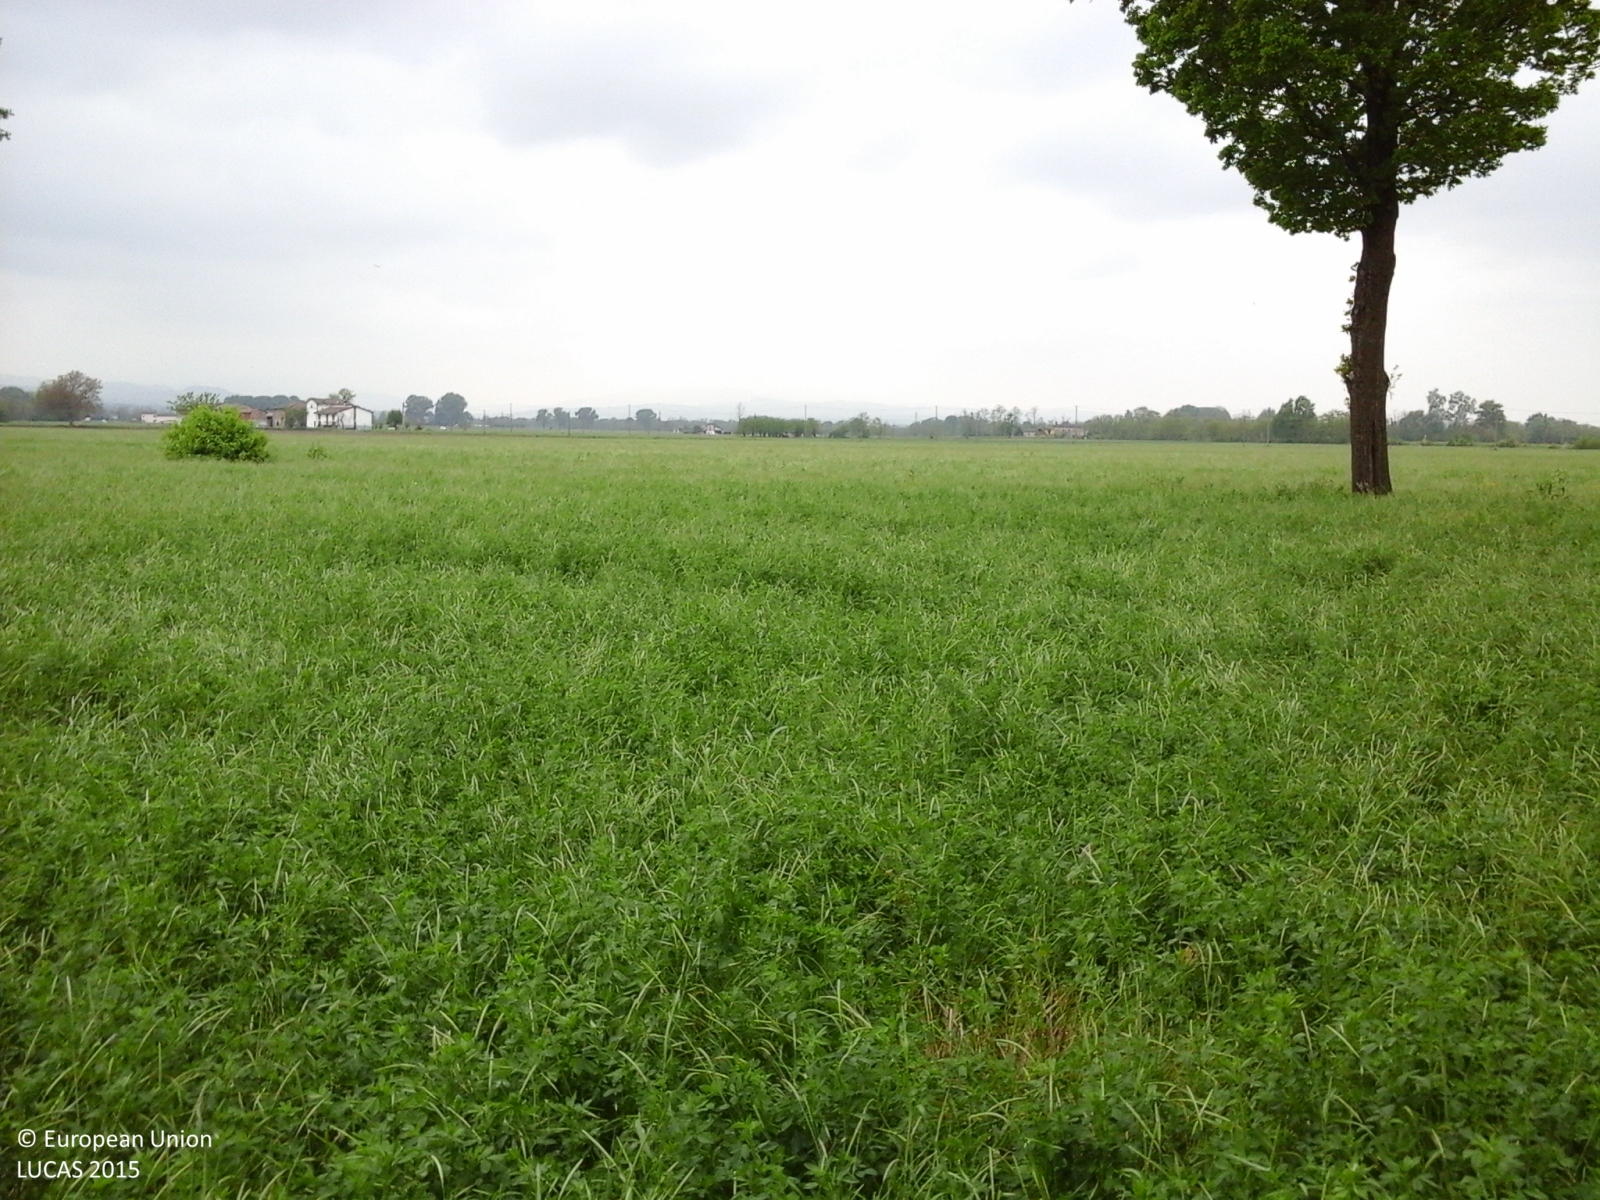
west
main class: Cropland
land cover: Lucerne
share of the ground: > 75 %
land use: Agriculture (excluding fallow land and kitchen gardens)
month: April
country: IT
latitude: 45.0167
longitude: 9.5314
